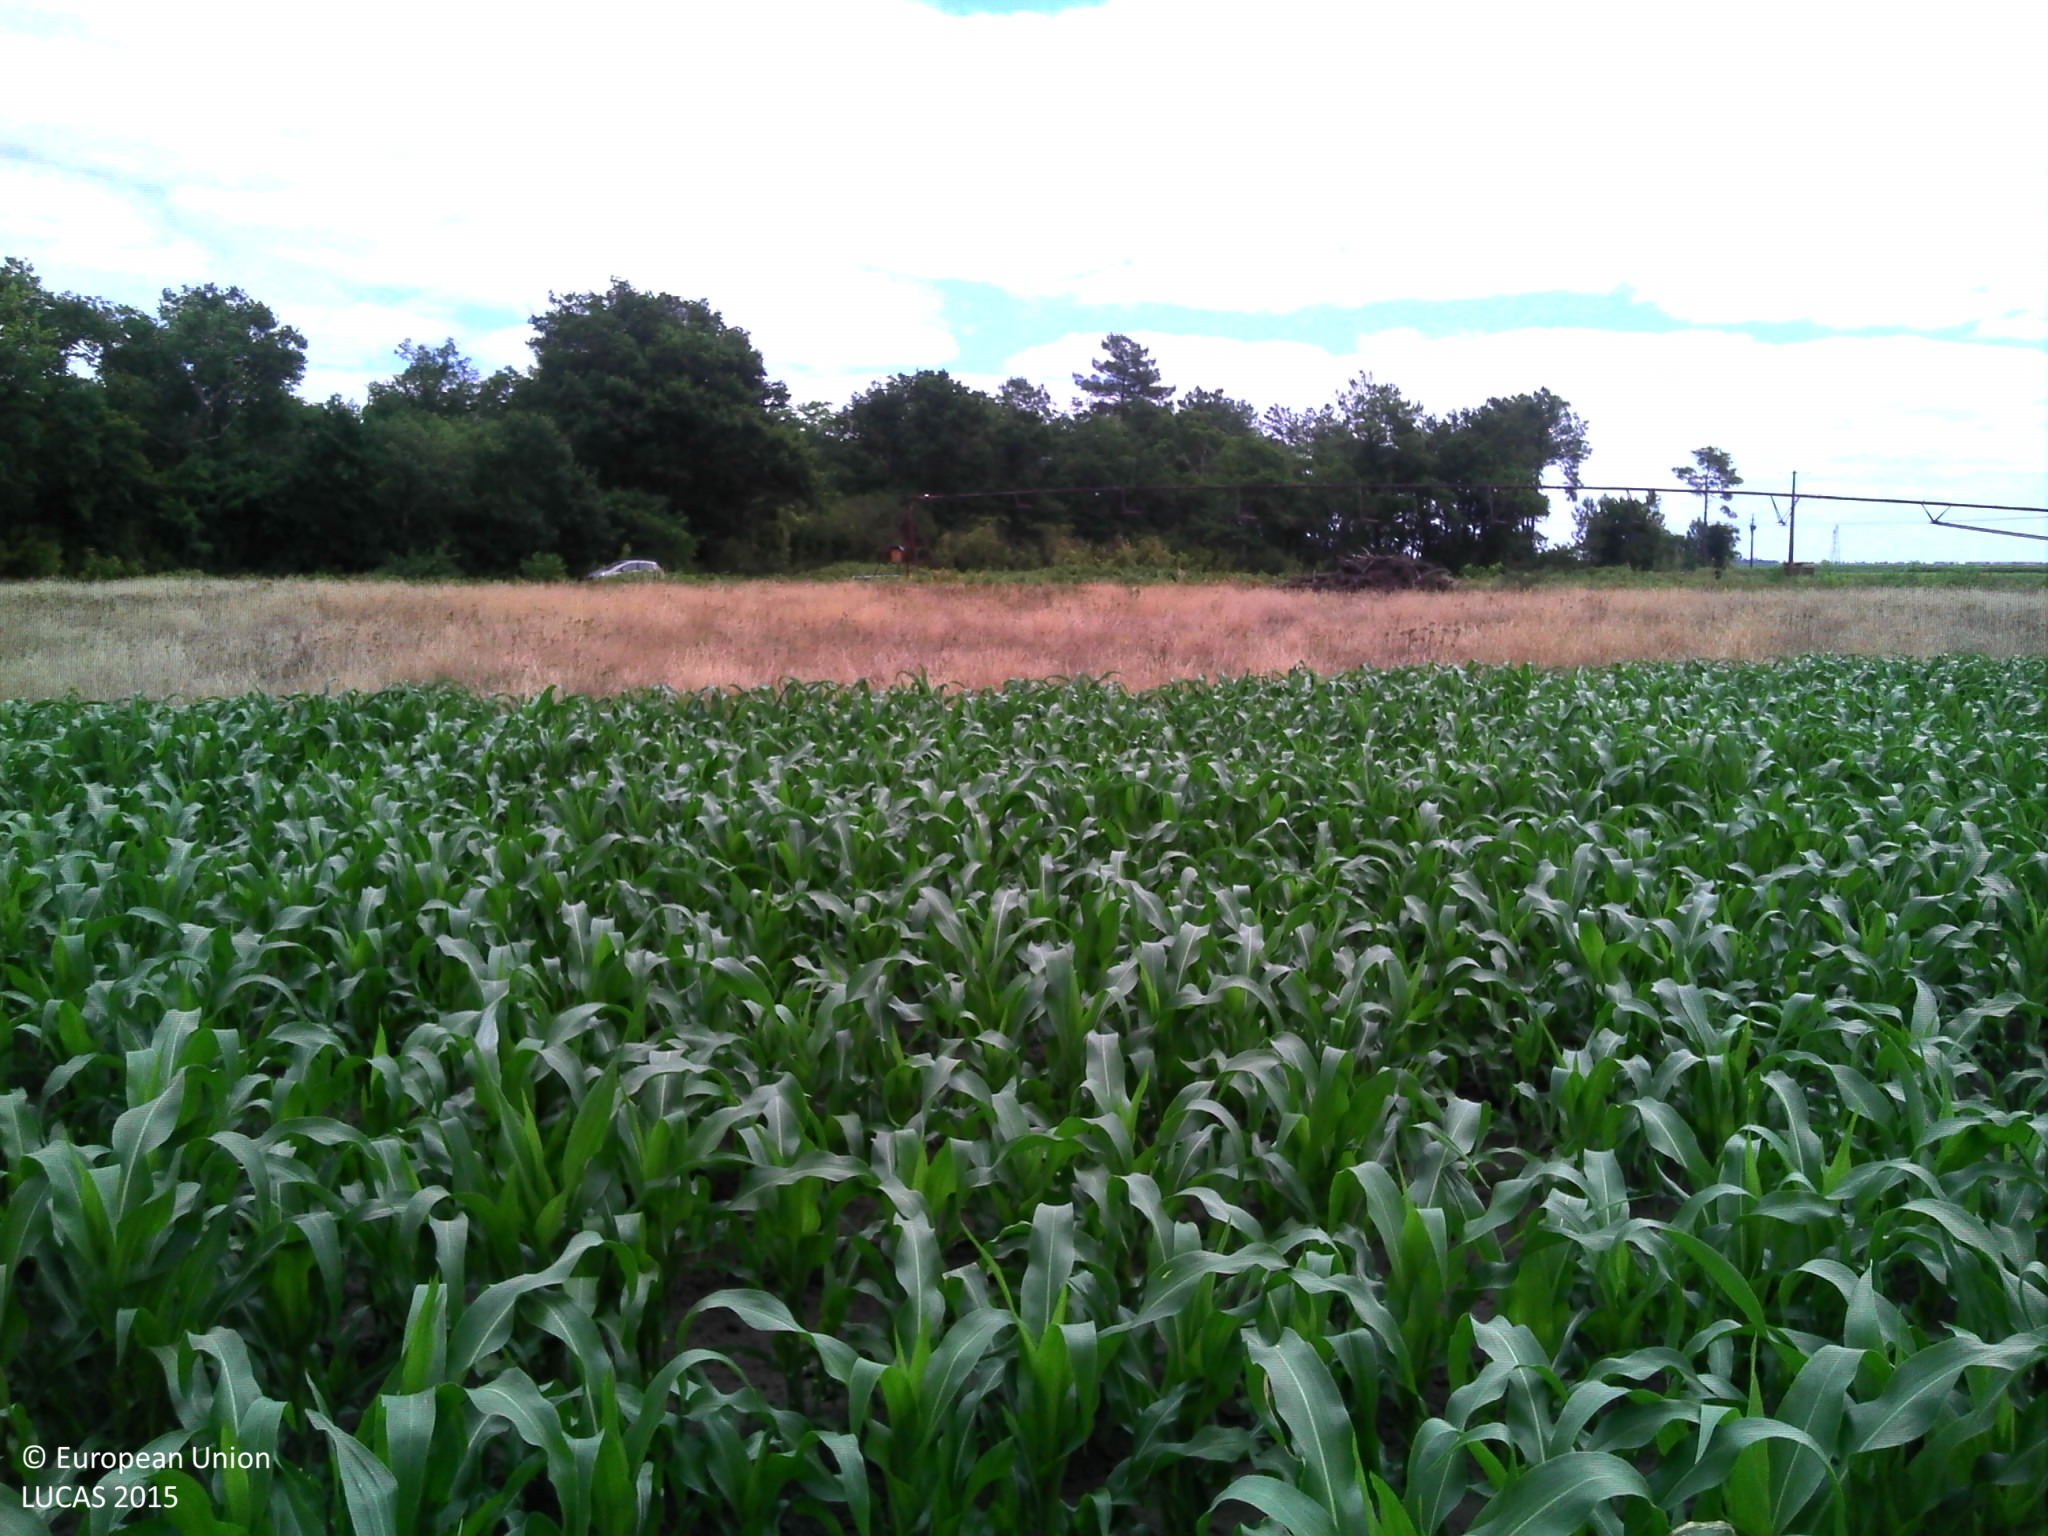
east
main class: Cropland
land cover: Maize
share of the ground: > 75 %
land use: Agriculture (excluding fallow land and kitchen gardens)
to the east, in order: Maize; Grassland without tree/shrub cover; Ditches and canals; Grass margins; Tracks; Ditches and canals; Sand; Tracks; Shruby margins; Rivers and streams; Broadleaved woodland; Pine dominated coniferous woodland
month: July
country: FR
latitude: 44.1048
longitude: -0.8730
